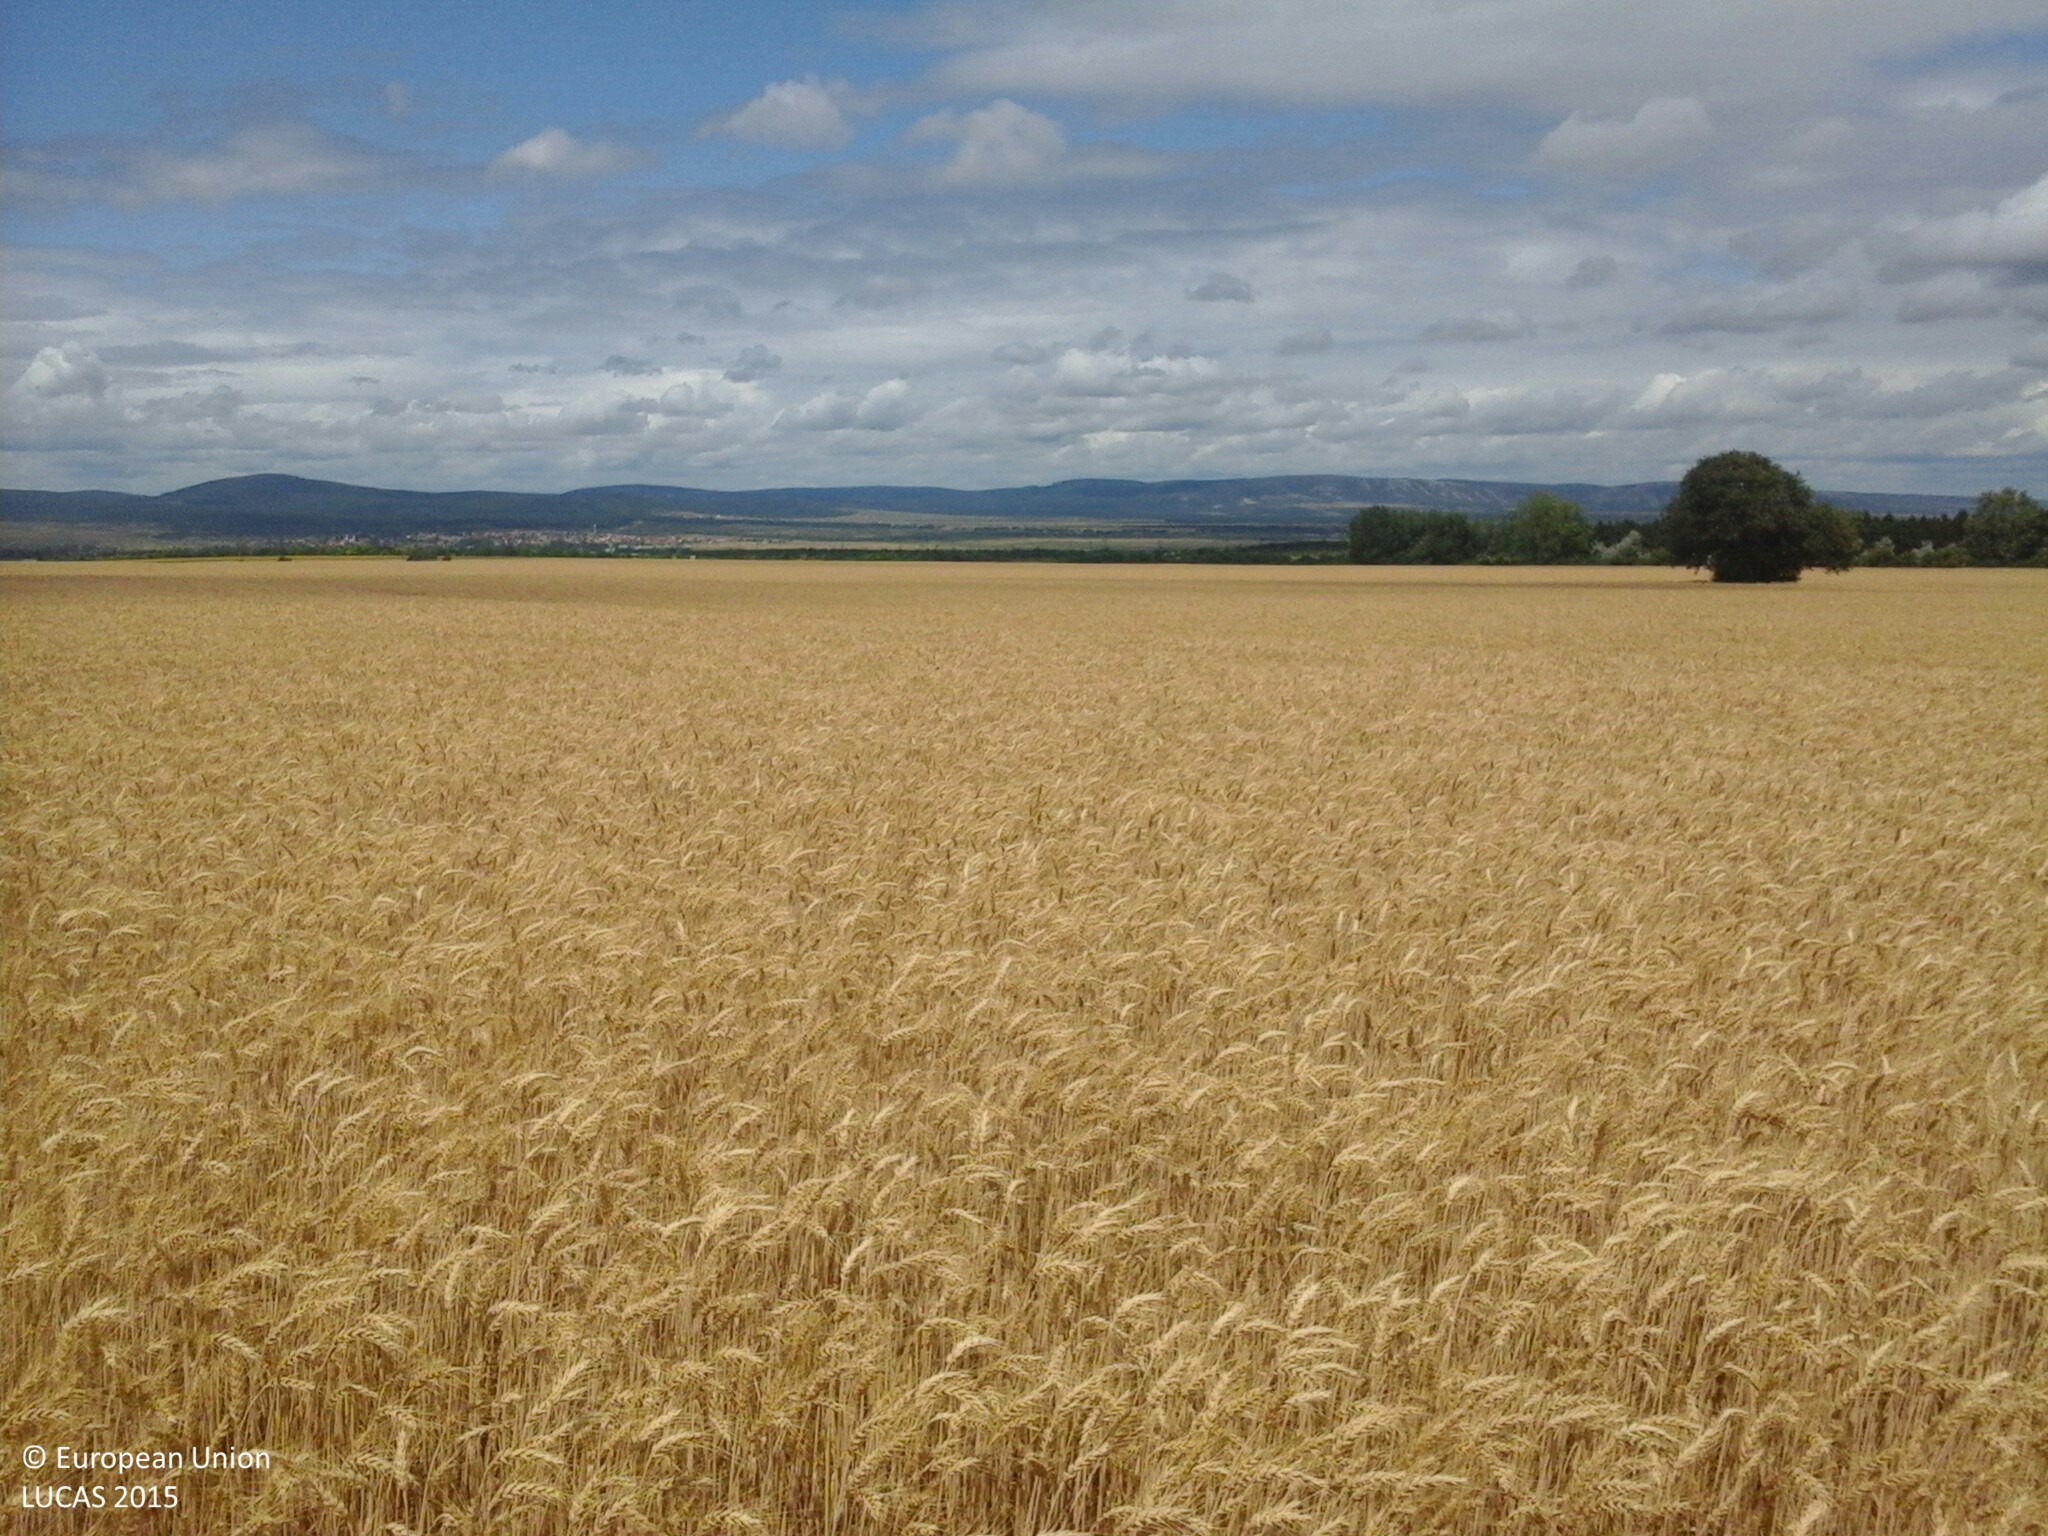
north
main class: Cropland
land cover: Durum wheat
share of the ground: > 75 %
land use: Agriculture (excluding fallow land and kitchen gardens)
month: July
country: HU
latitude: 47.0861
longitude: 17.9520
